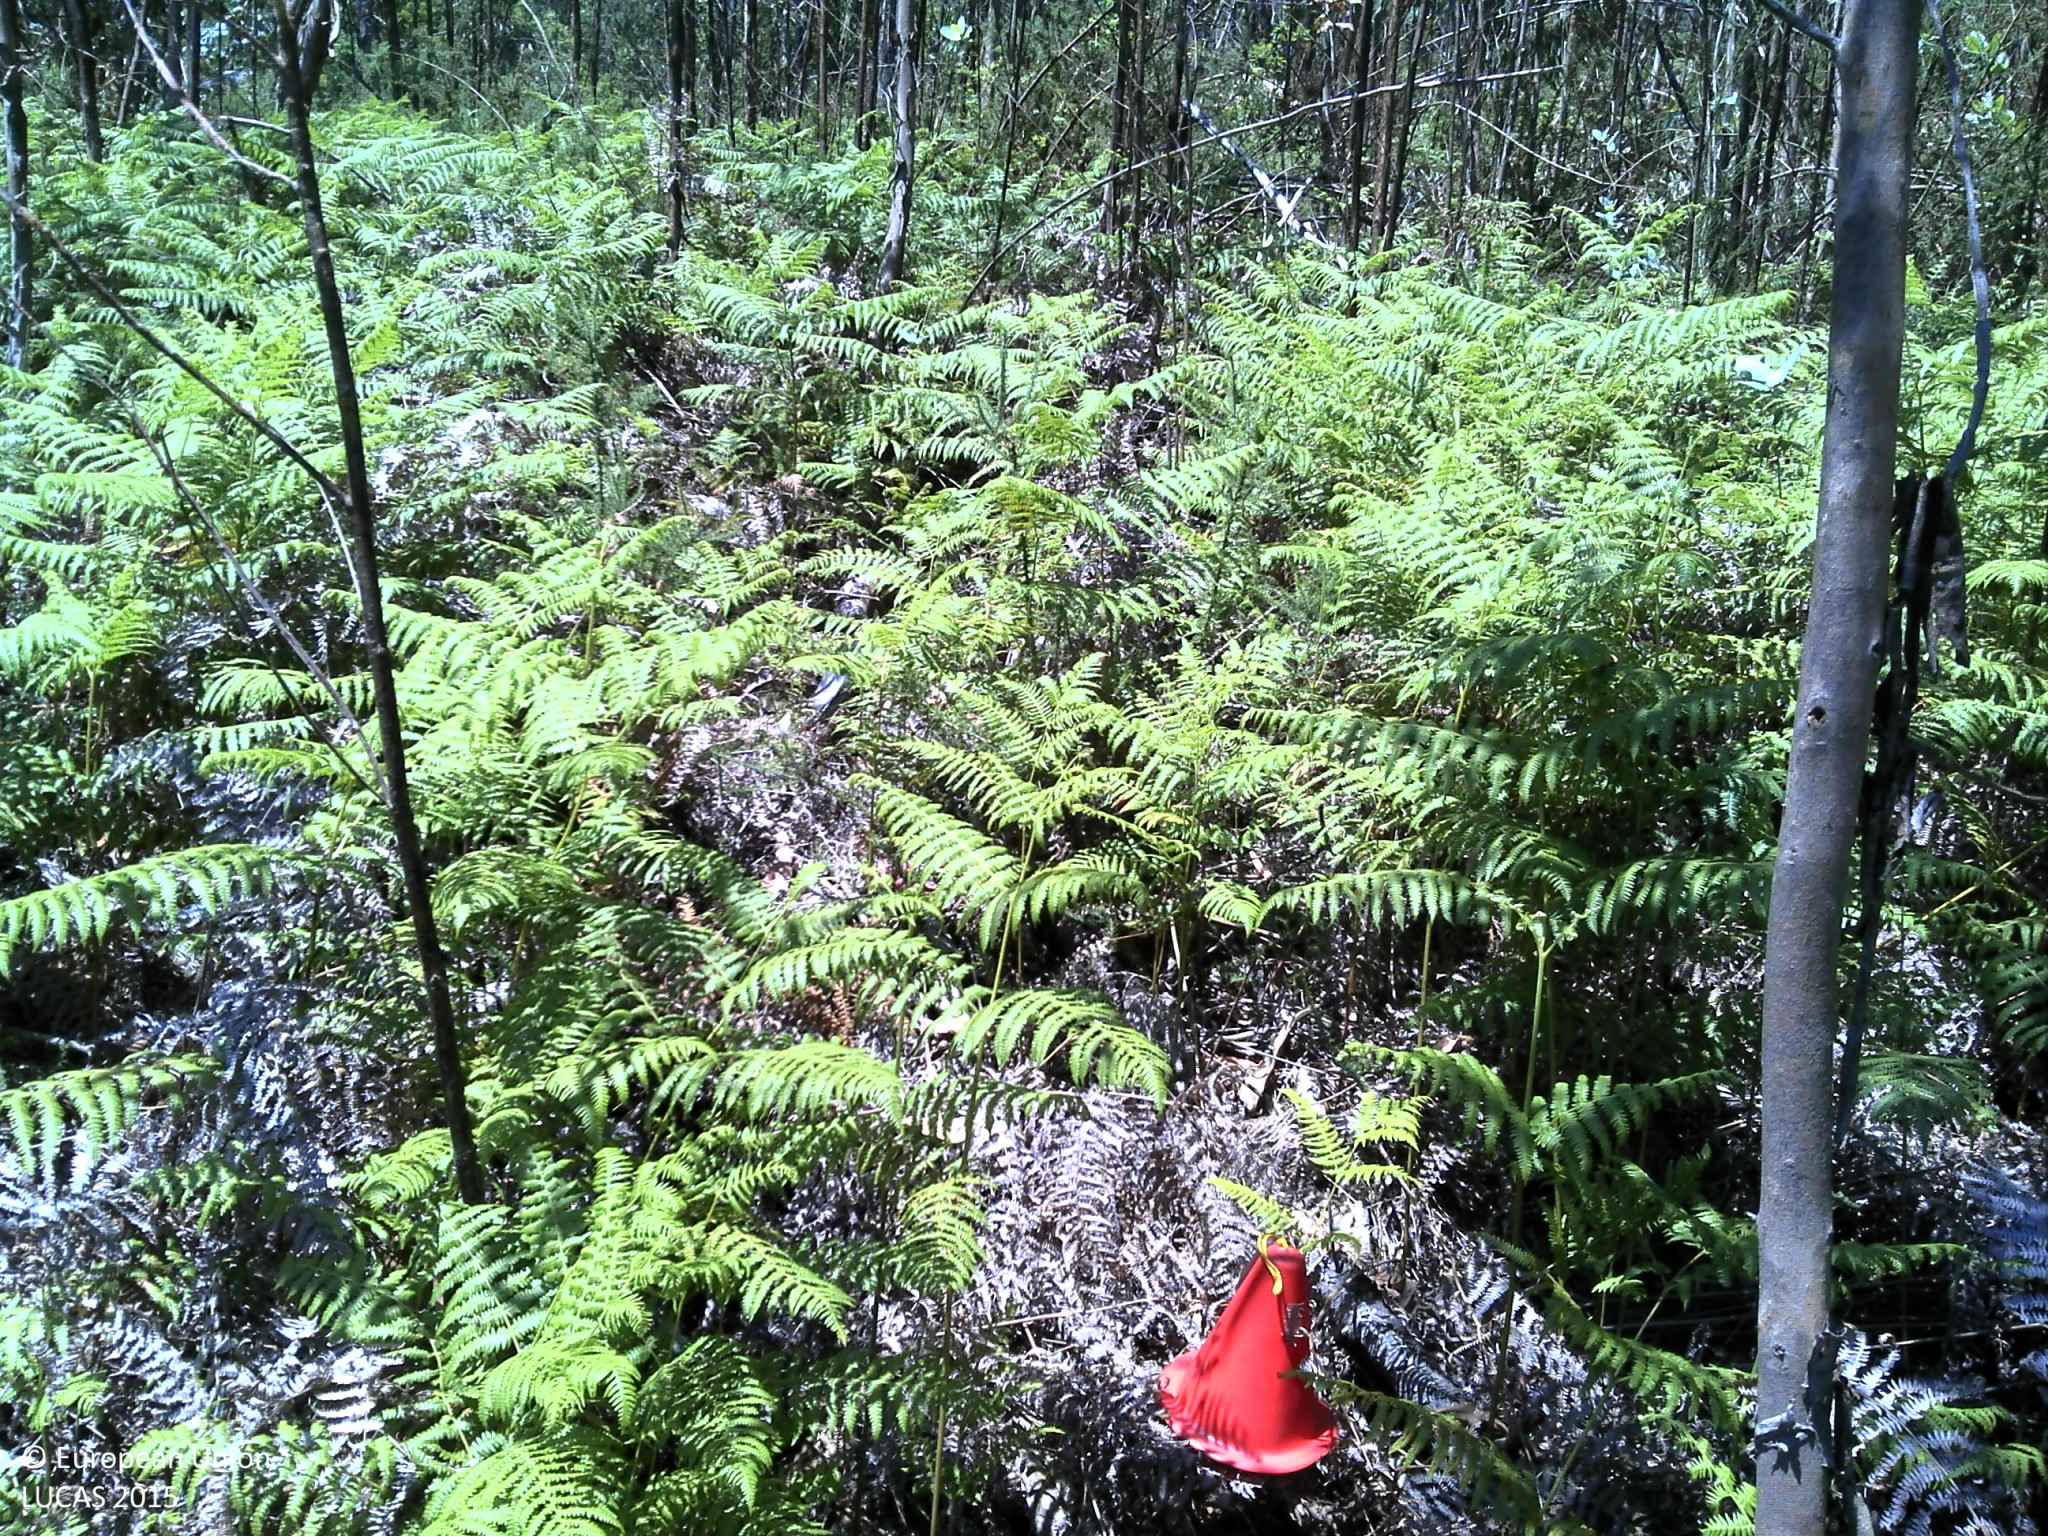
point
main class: Woodland
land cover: Broadleaved woodland
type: exotic forest
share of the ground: 25 - 50 %
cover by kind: broadleaved forest trees 50 %, shrubs 35 %, unconsolidated bare surface 10 %, herbaceous plants 5 %
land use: Forestry
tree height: > 5 m
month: May
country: PT
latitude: 41.6843
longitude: -8.6270
